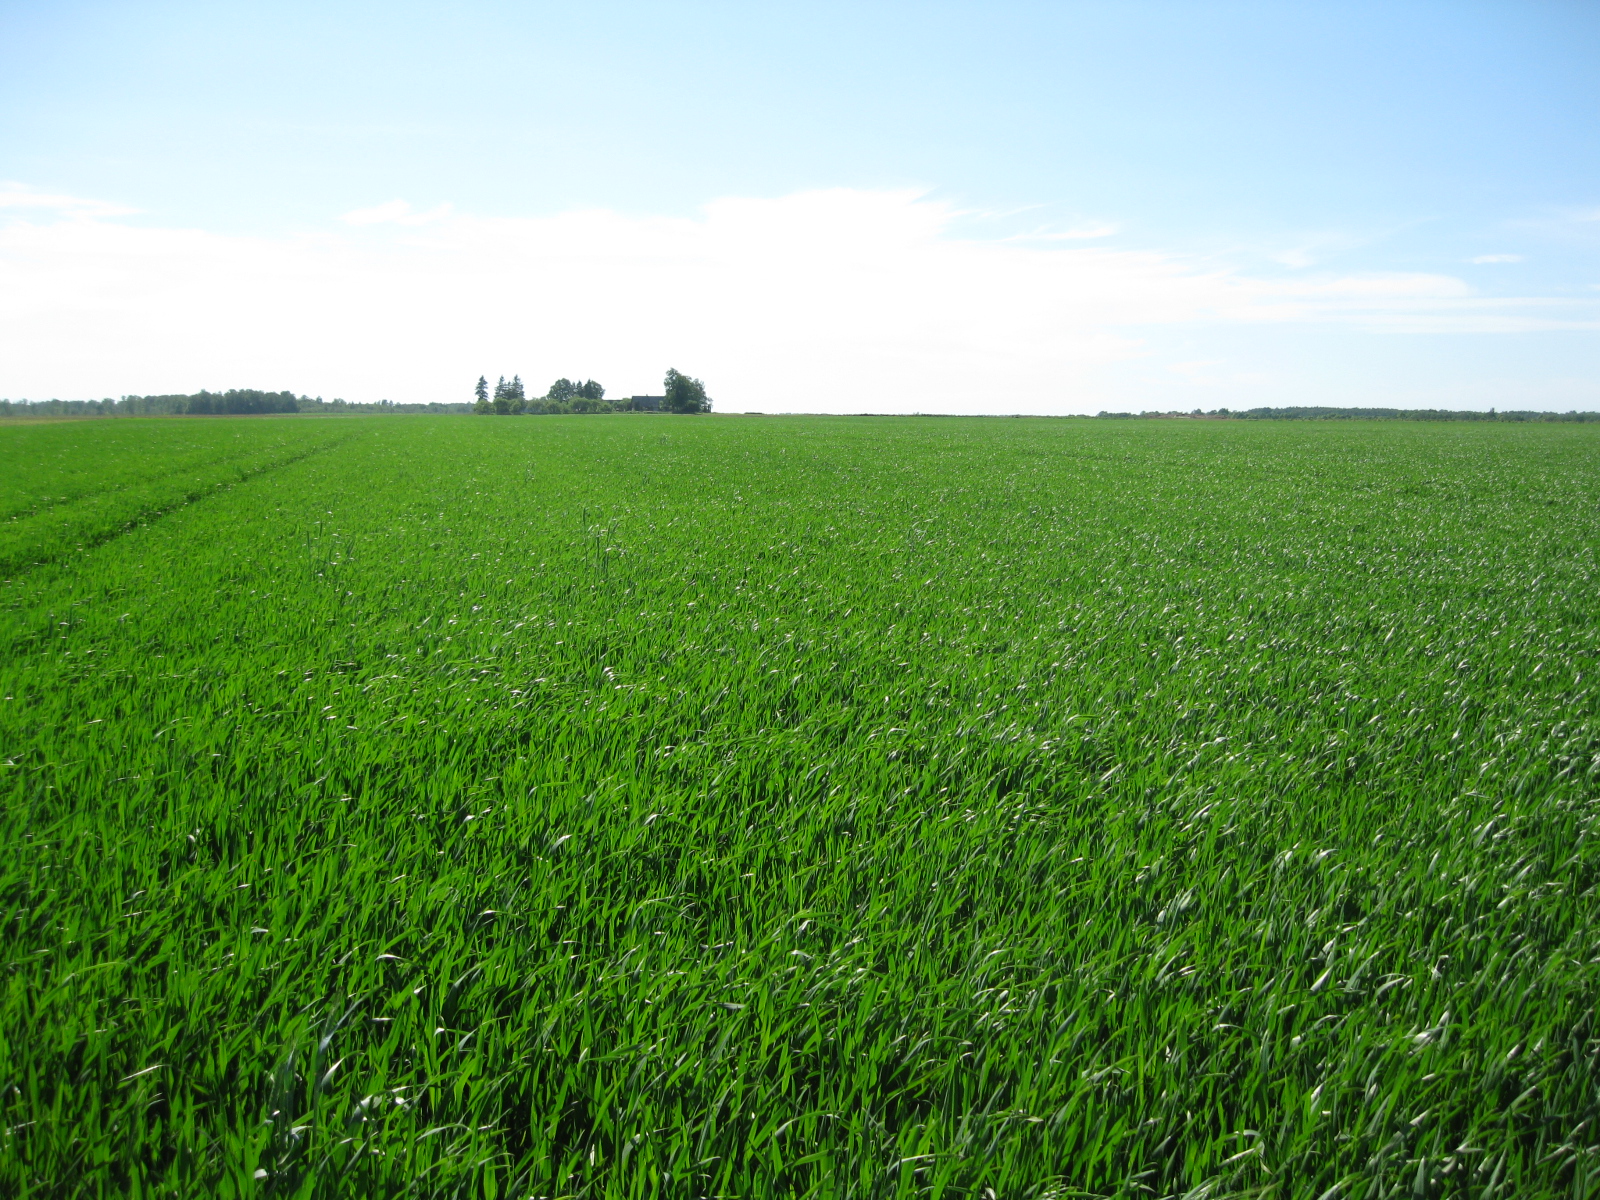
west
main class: Cropland
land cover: Common wheat
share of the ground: > 75 %
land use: Agriculture (excluding fallow land and kitchen gardens)
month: June
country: LT
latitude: 55.8674
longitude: 23.8760
